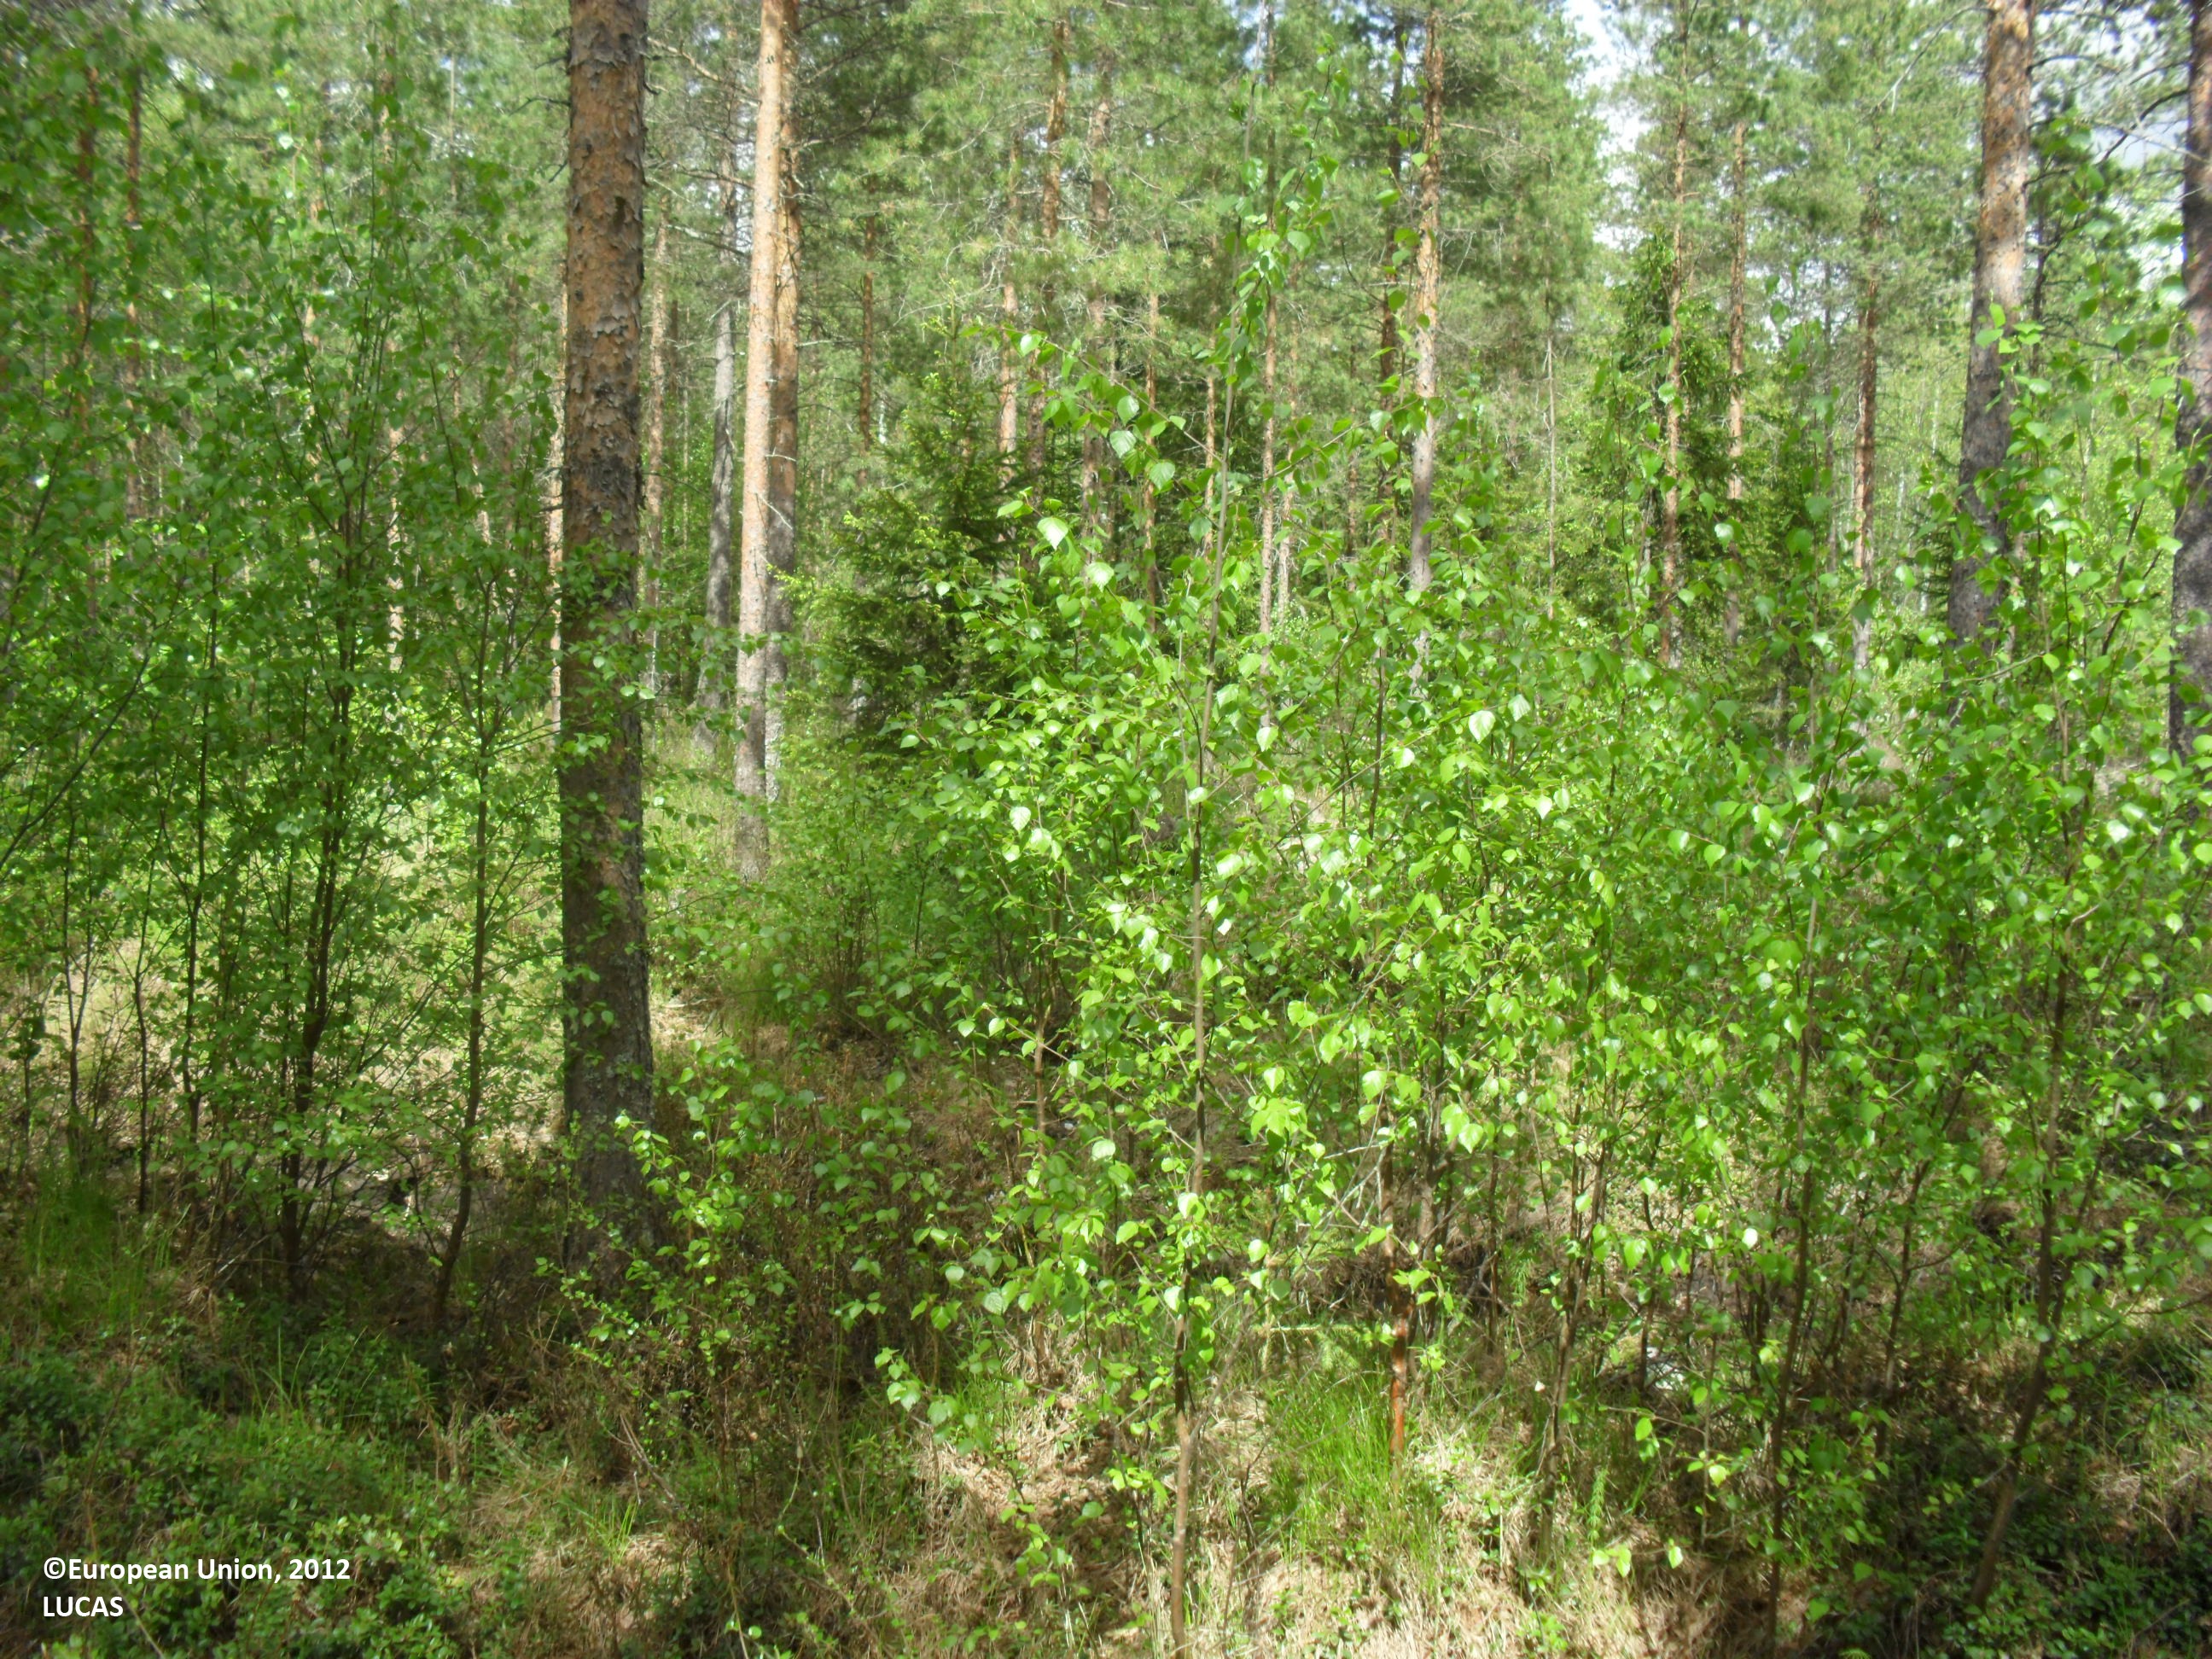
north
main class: Woodland
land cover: Pine dominated coniferous woodland
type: boreal forest
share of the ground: 50 - 75 %
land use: Forestry
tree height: > 5 m
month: June
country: FI
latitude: 63.1417
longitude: 23.2549
